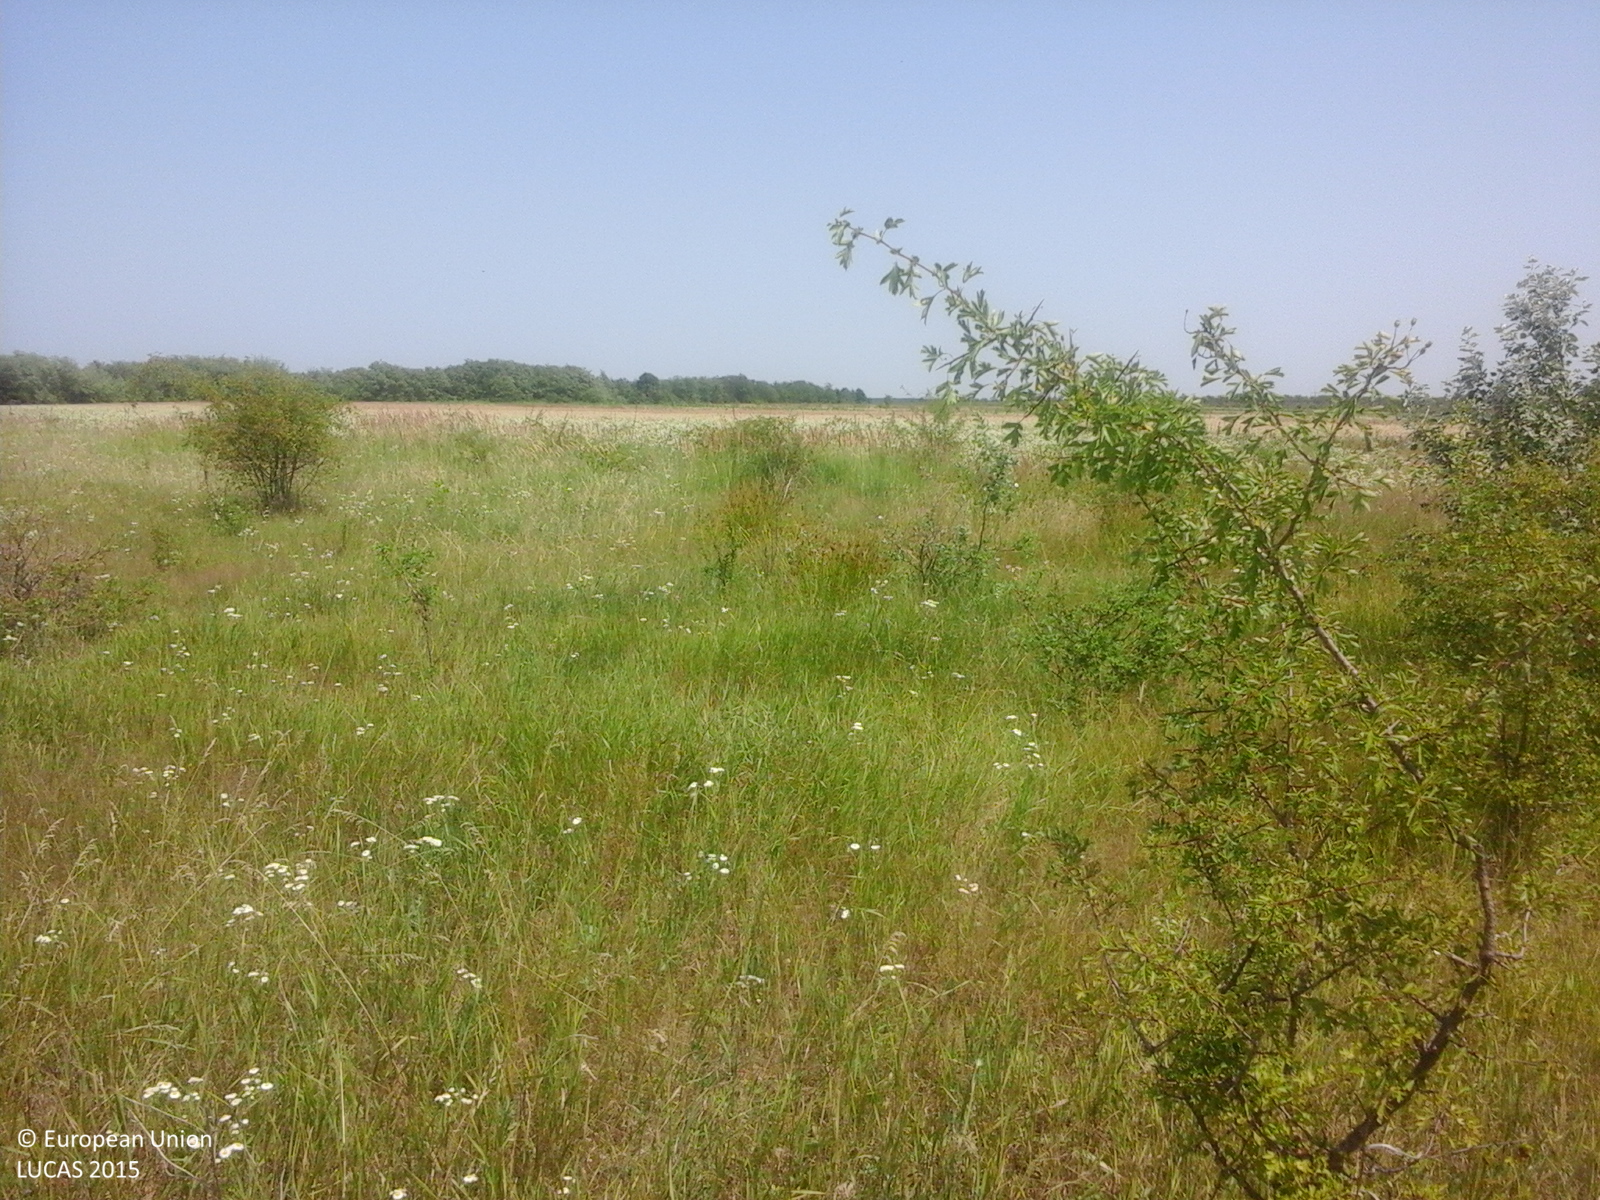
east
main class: Grassland
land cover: Grassland with sparse tree/shrub cover
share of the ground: > 75 %
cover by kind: herbaceous plants 95 %, broadleaved forest trees 5 %
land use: Agriculture (excluding fallow land and kitchen gardens)
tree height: < 5 m
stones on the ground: < 10 %
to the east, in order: Grassland with sparse tree/shrub cover; Spontaneously vegetated surfaces; Common wheat; Spontaneously vegetated surfaces; Common wheat; Spontaneously vegetated surfaces; Maize; Grass margins; Maize; Oats; Grass margins; Maize
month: July
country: RO
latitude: 44.7657
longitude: 24.7985
